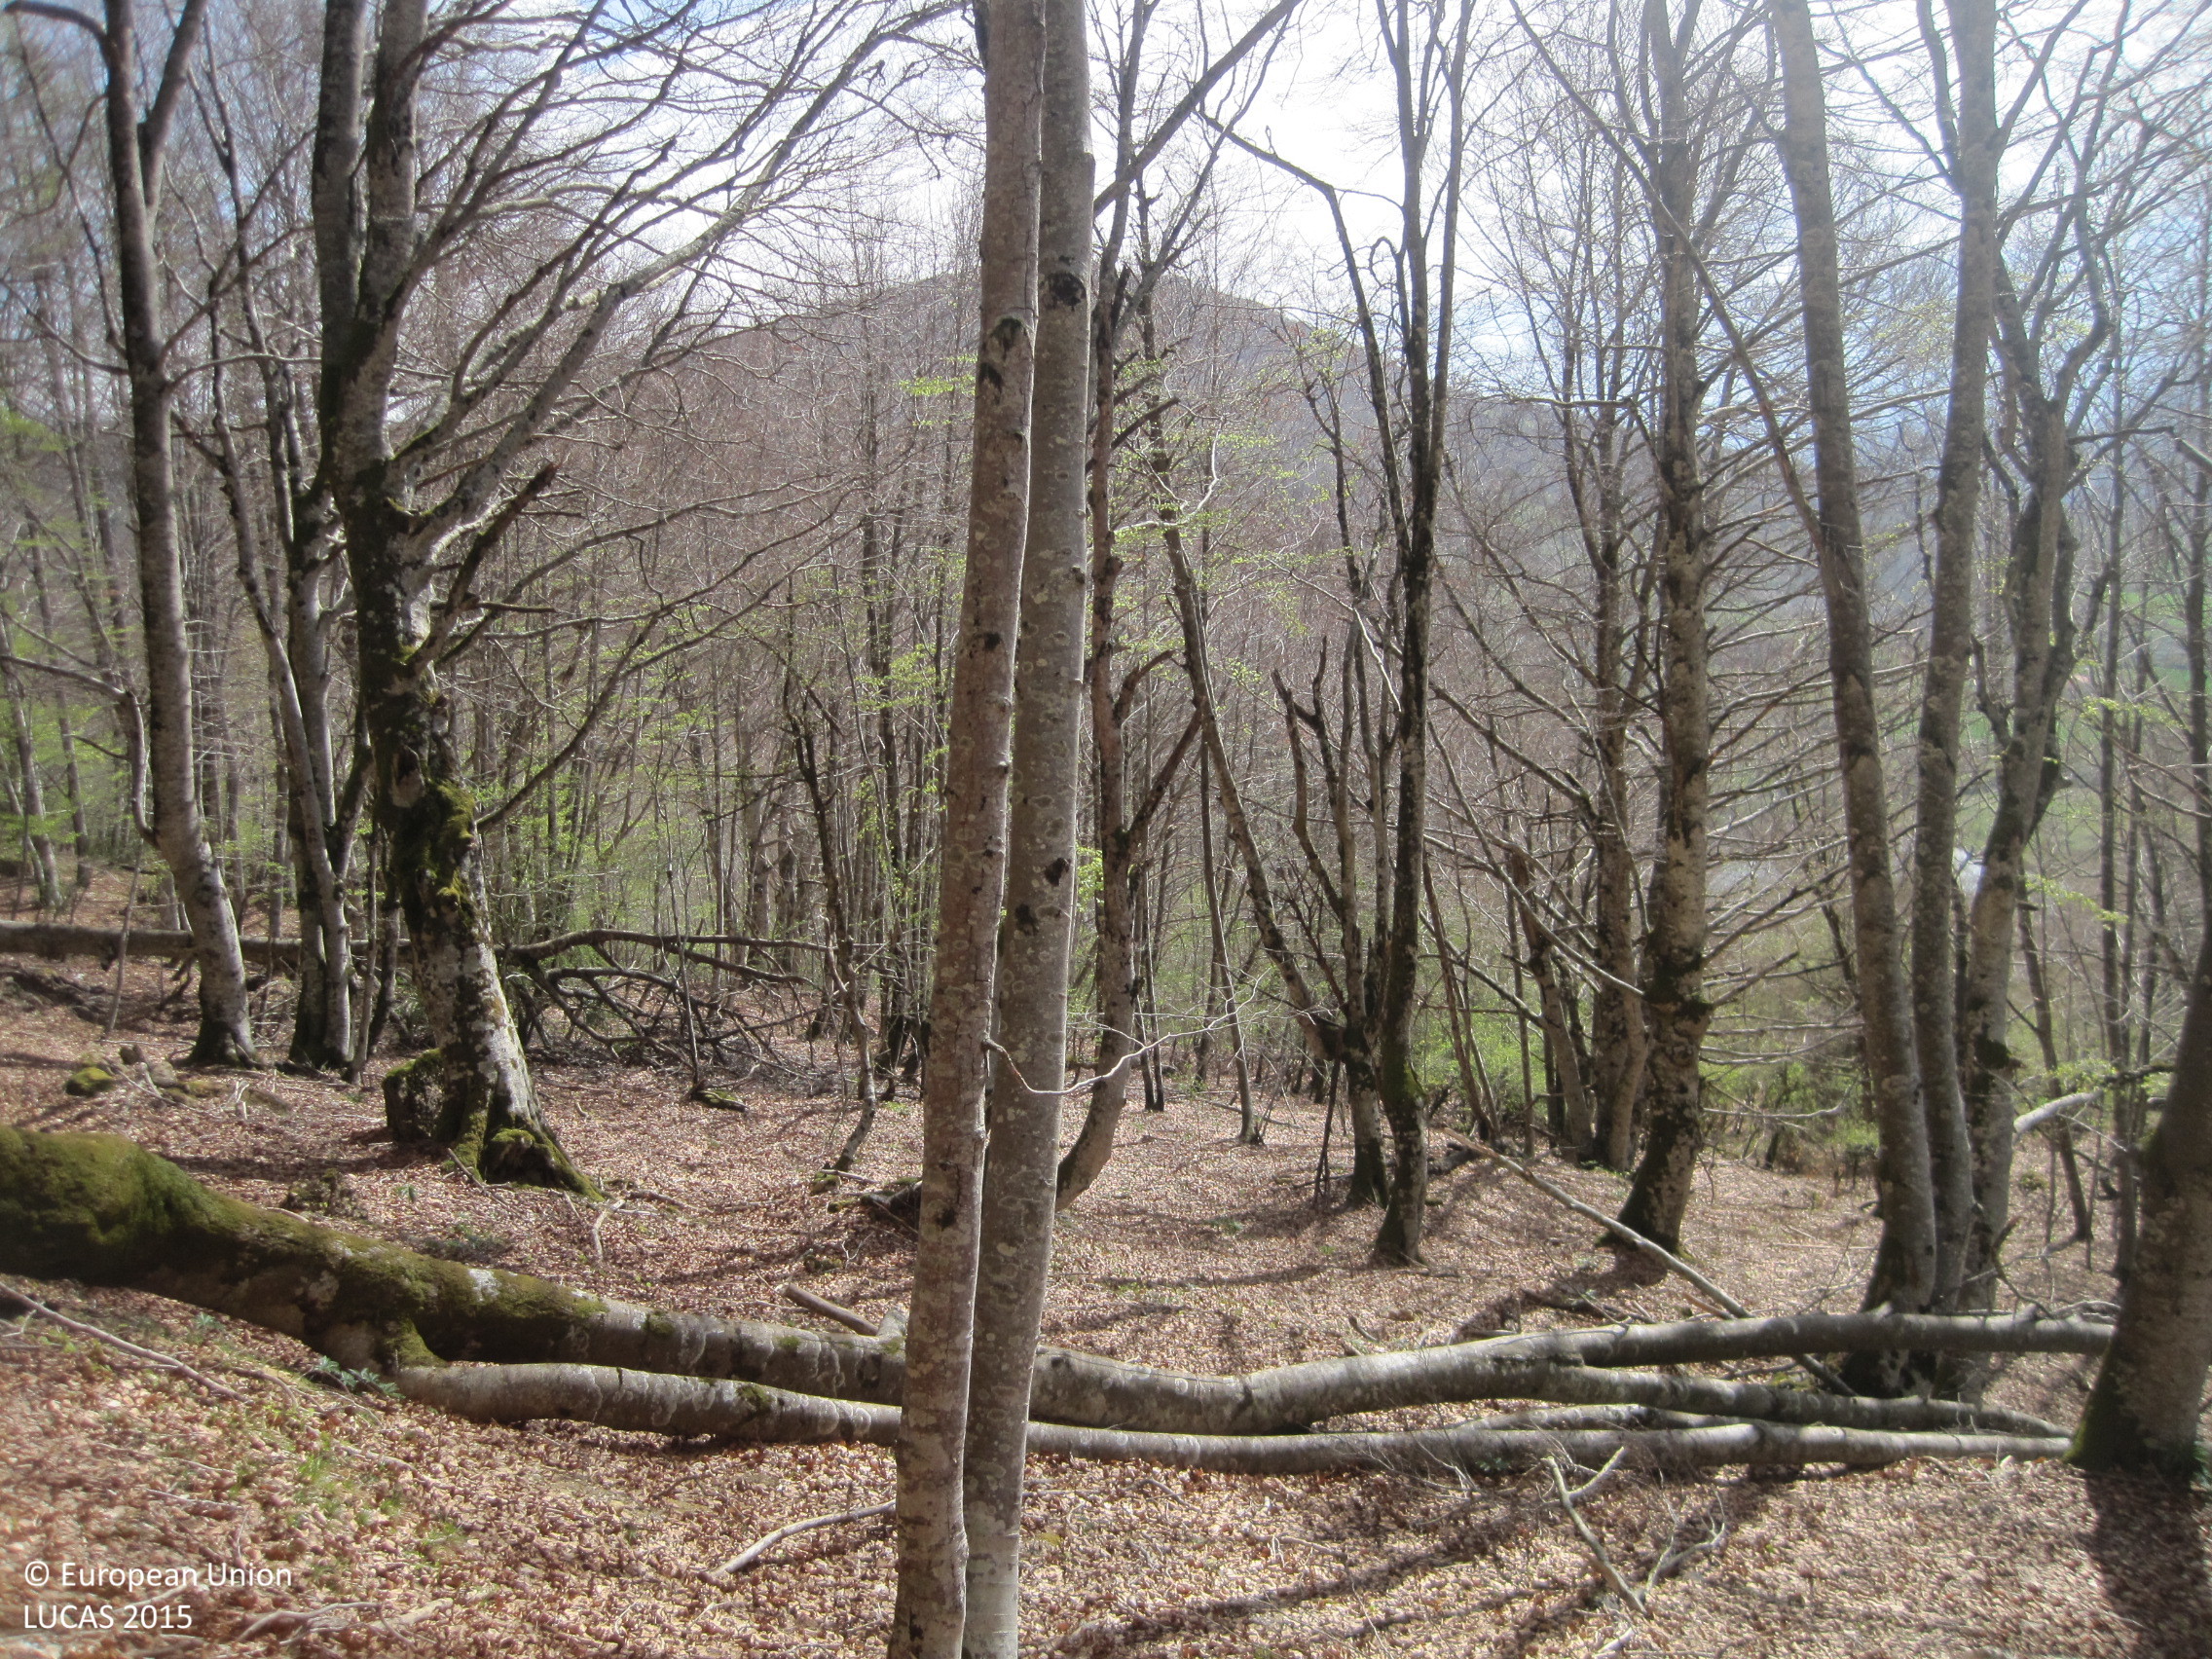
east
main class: Woodland
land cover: Broadleaved woodland
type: beech forest
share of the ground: > 75 %
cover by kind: broadleaved forest trees 100 %
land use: Forestry
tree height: > 5 m
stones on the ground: < 10 %
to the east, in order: Broadleaved woodland; Tracks; Broadleaved woodland
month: April
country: ES
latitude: 42.7734
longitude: -2.3294
